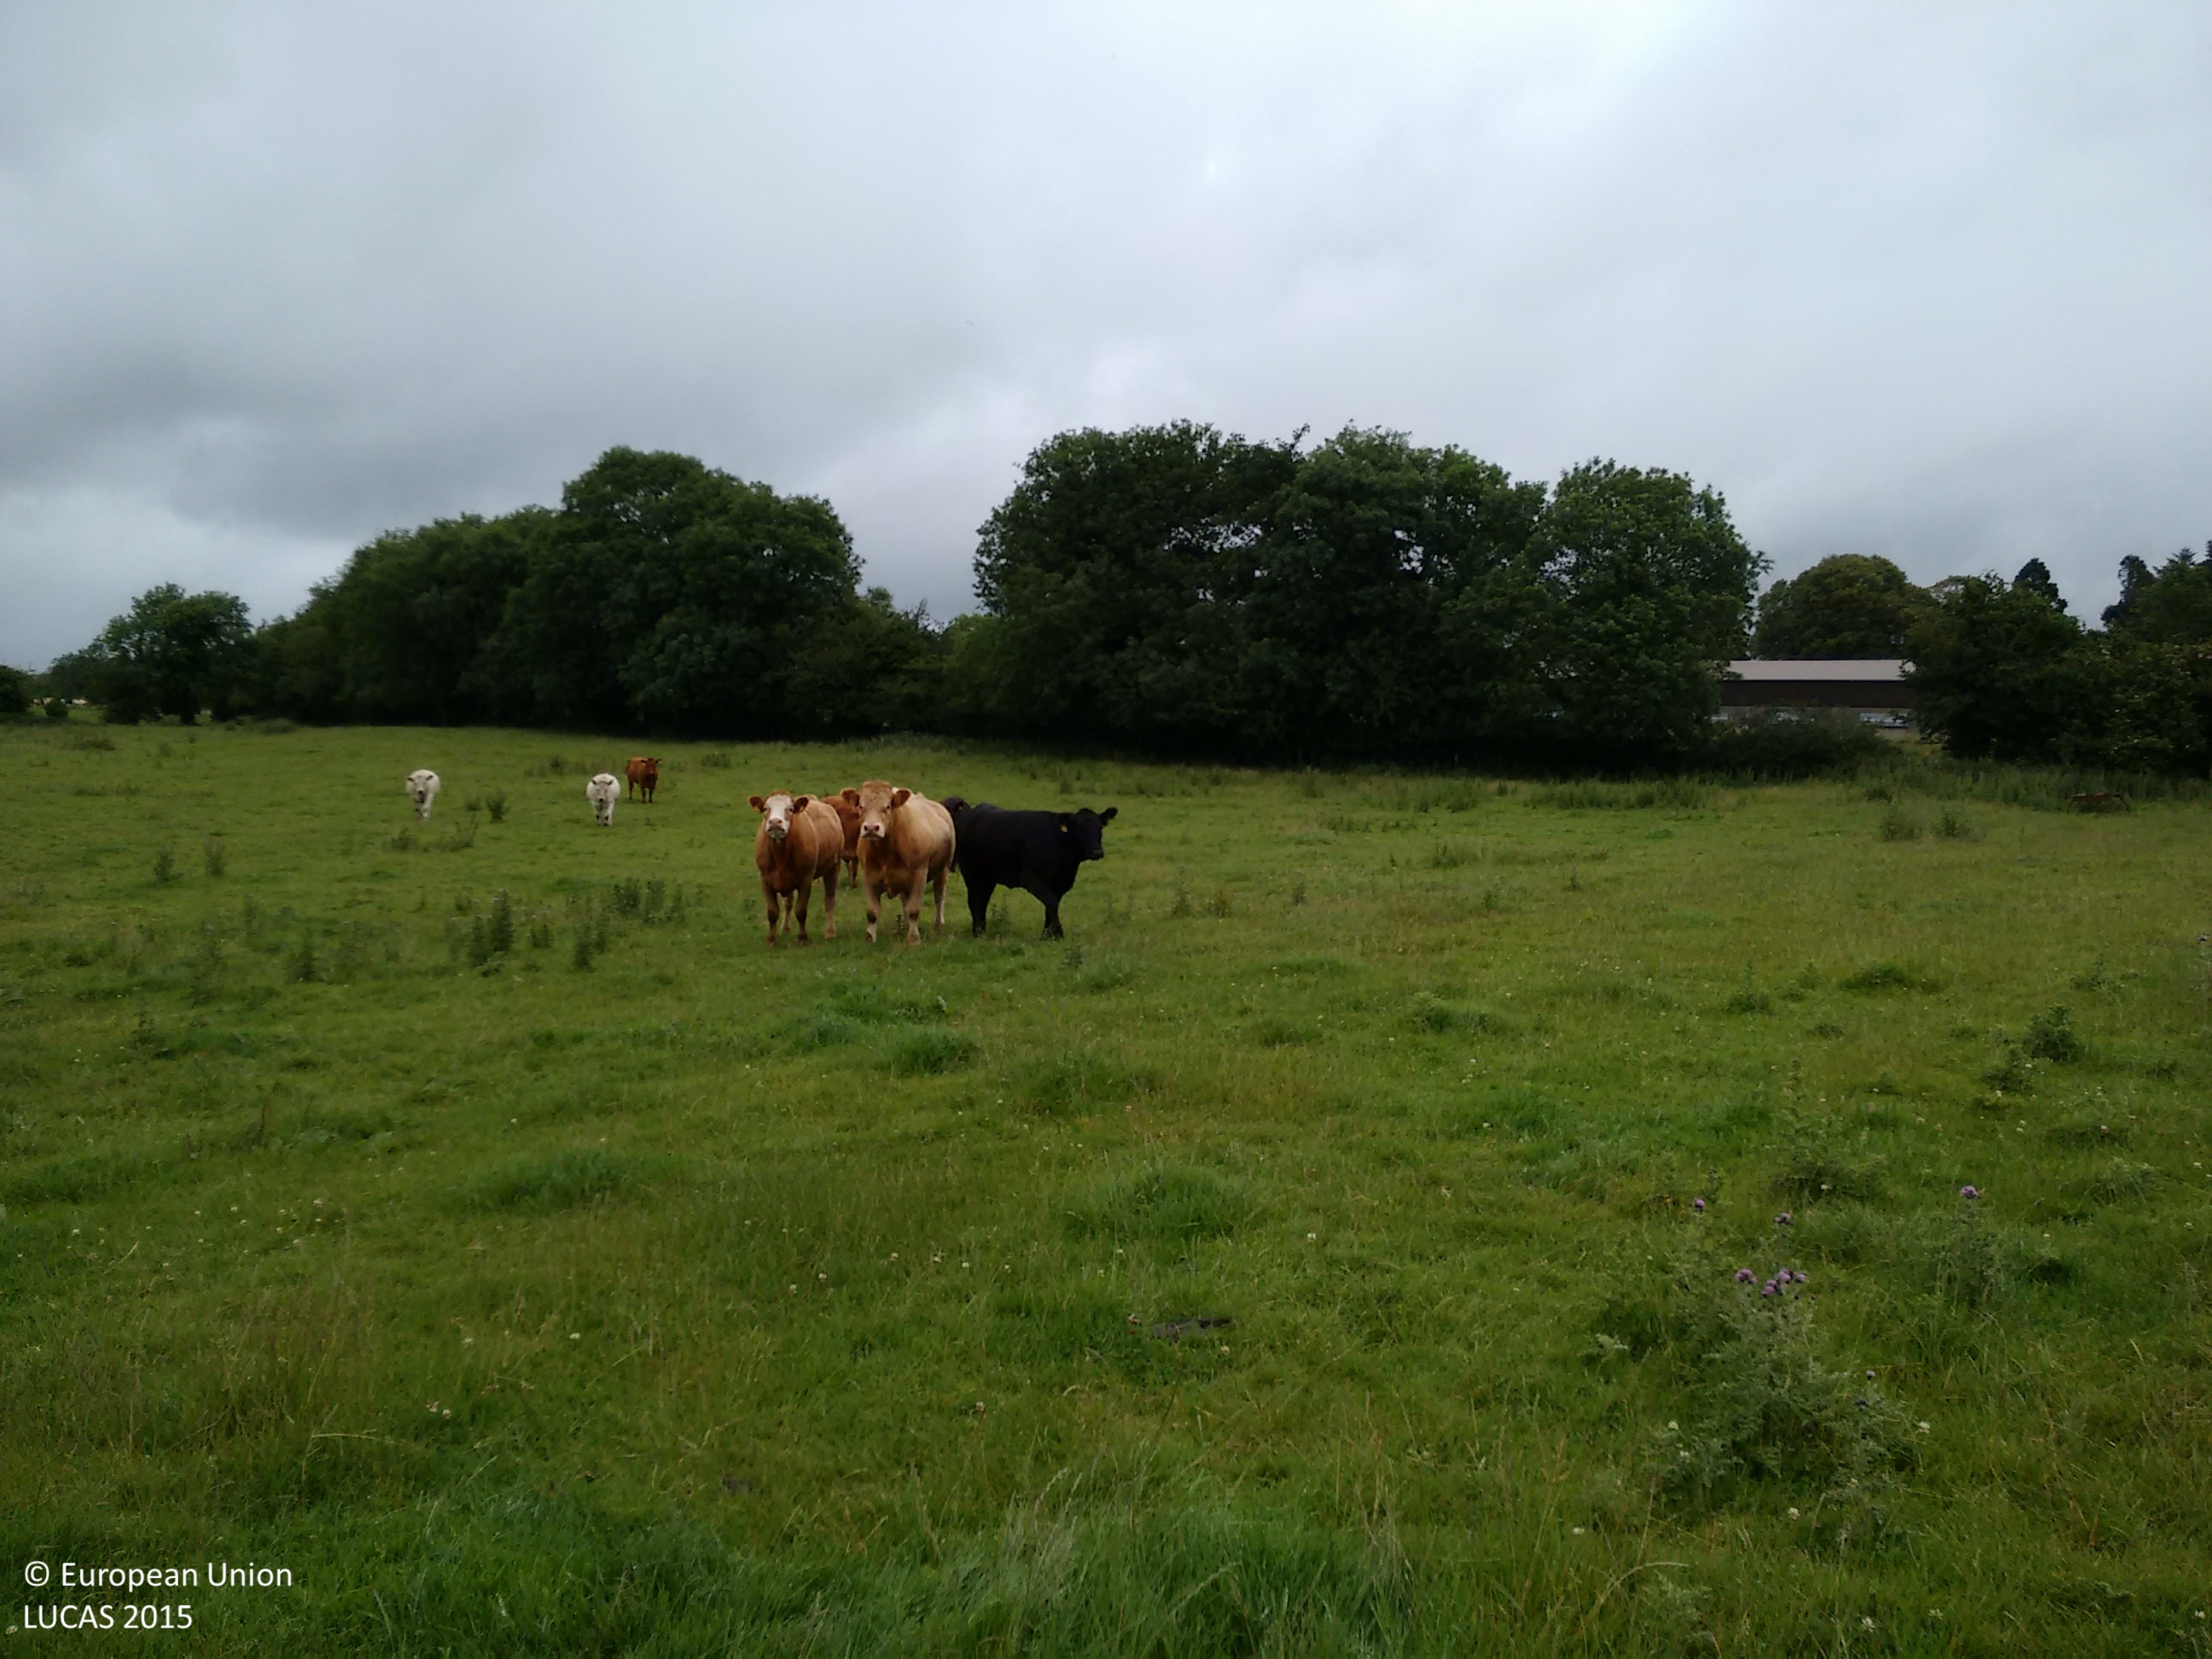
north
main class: Grassland
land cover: Grassland without tree/shrub cover
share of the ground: > 75 %
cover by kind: herbaceous plants 100 %
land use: Agriculture (excluding fallow land and kitchen gardens)
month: July
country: IE
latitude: 53.6543
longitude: -7.7947
